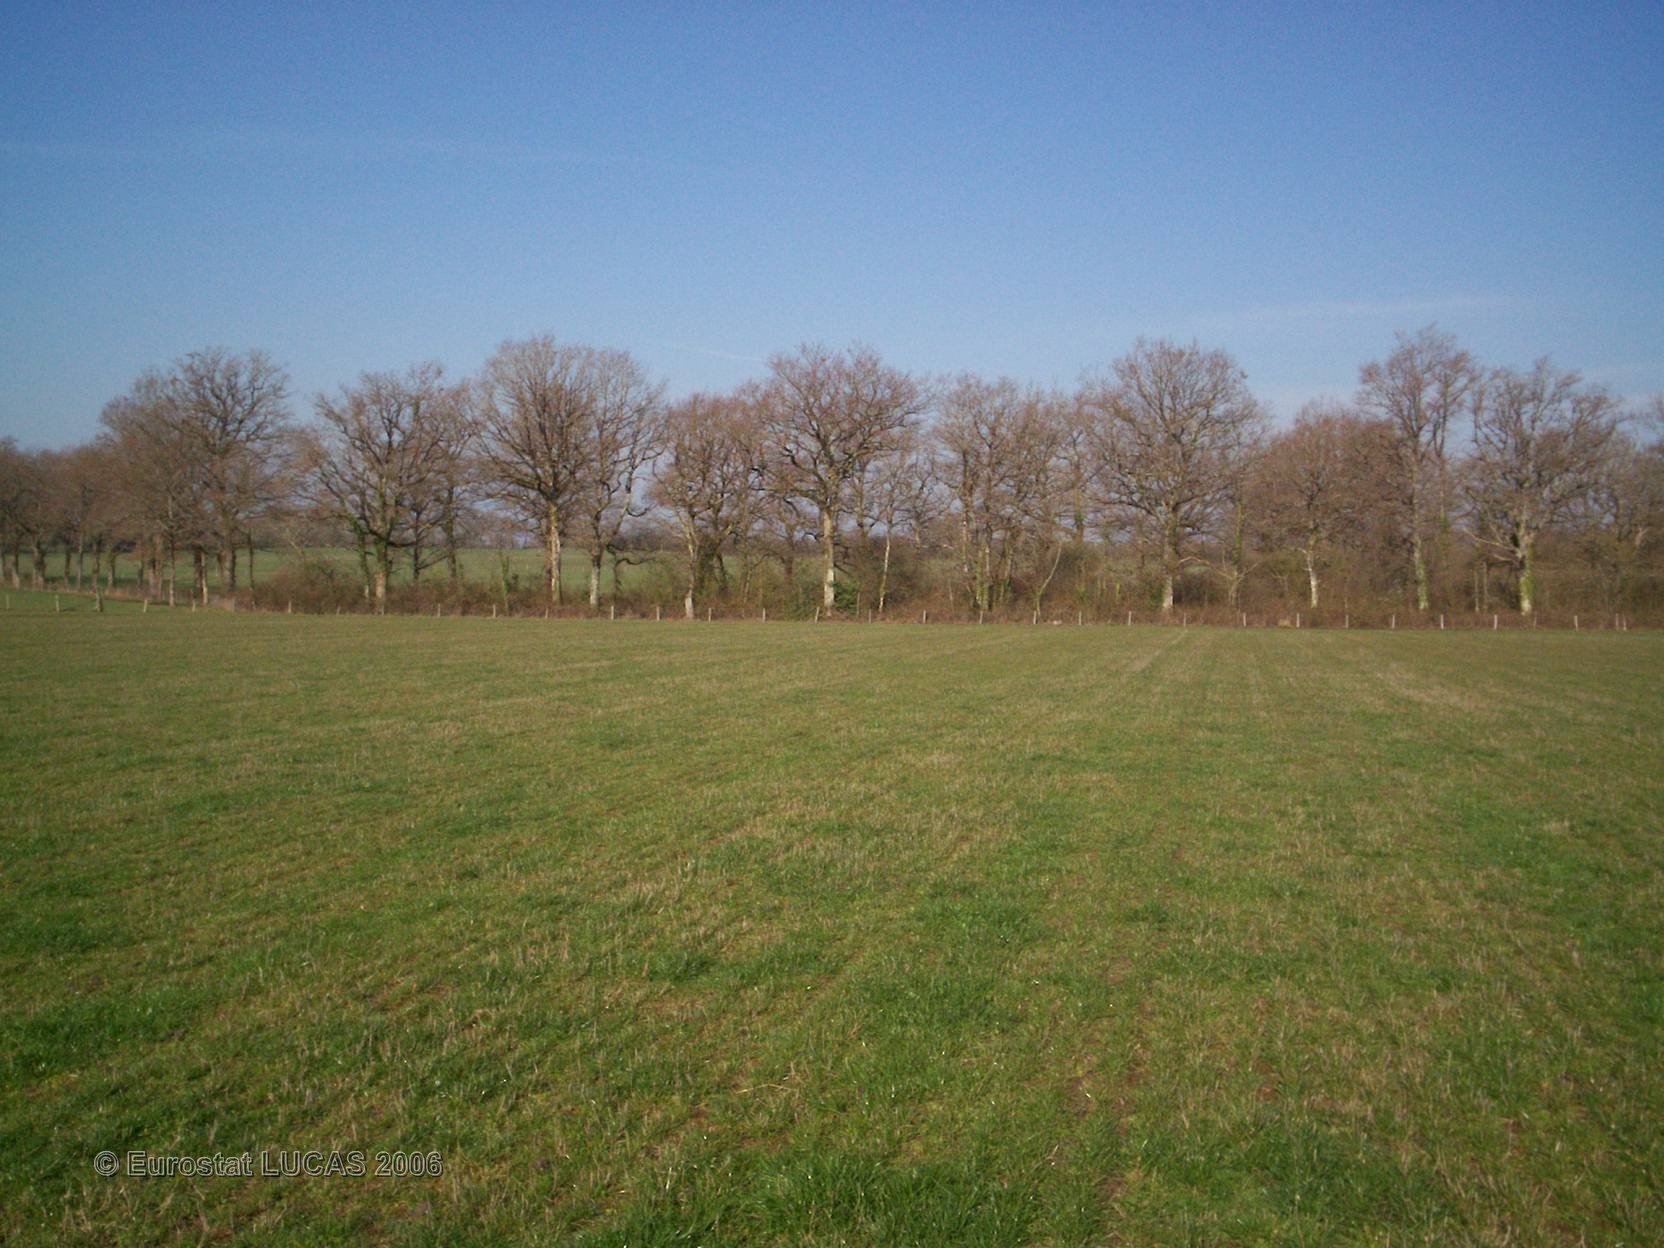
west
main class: Grassland
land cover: Grassland without tree/shrub cover
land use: Agriculture (excluding fallow land and kitchen gardens)
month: April
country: FR
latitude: 46.3230
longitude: 1.0908
